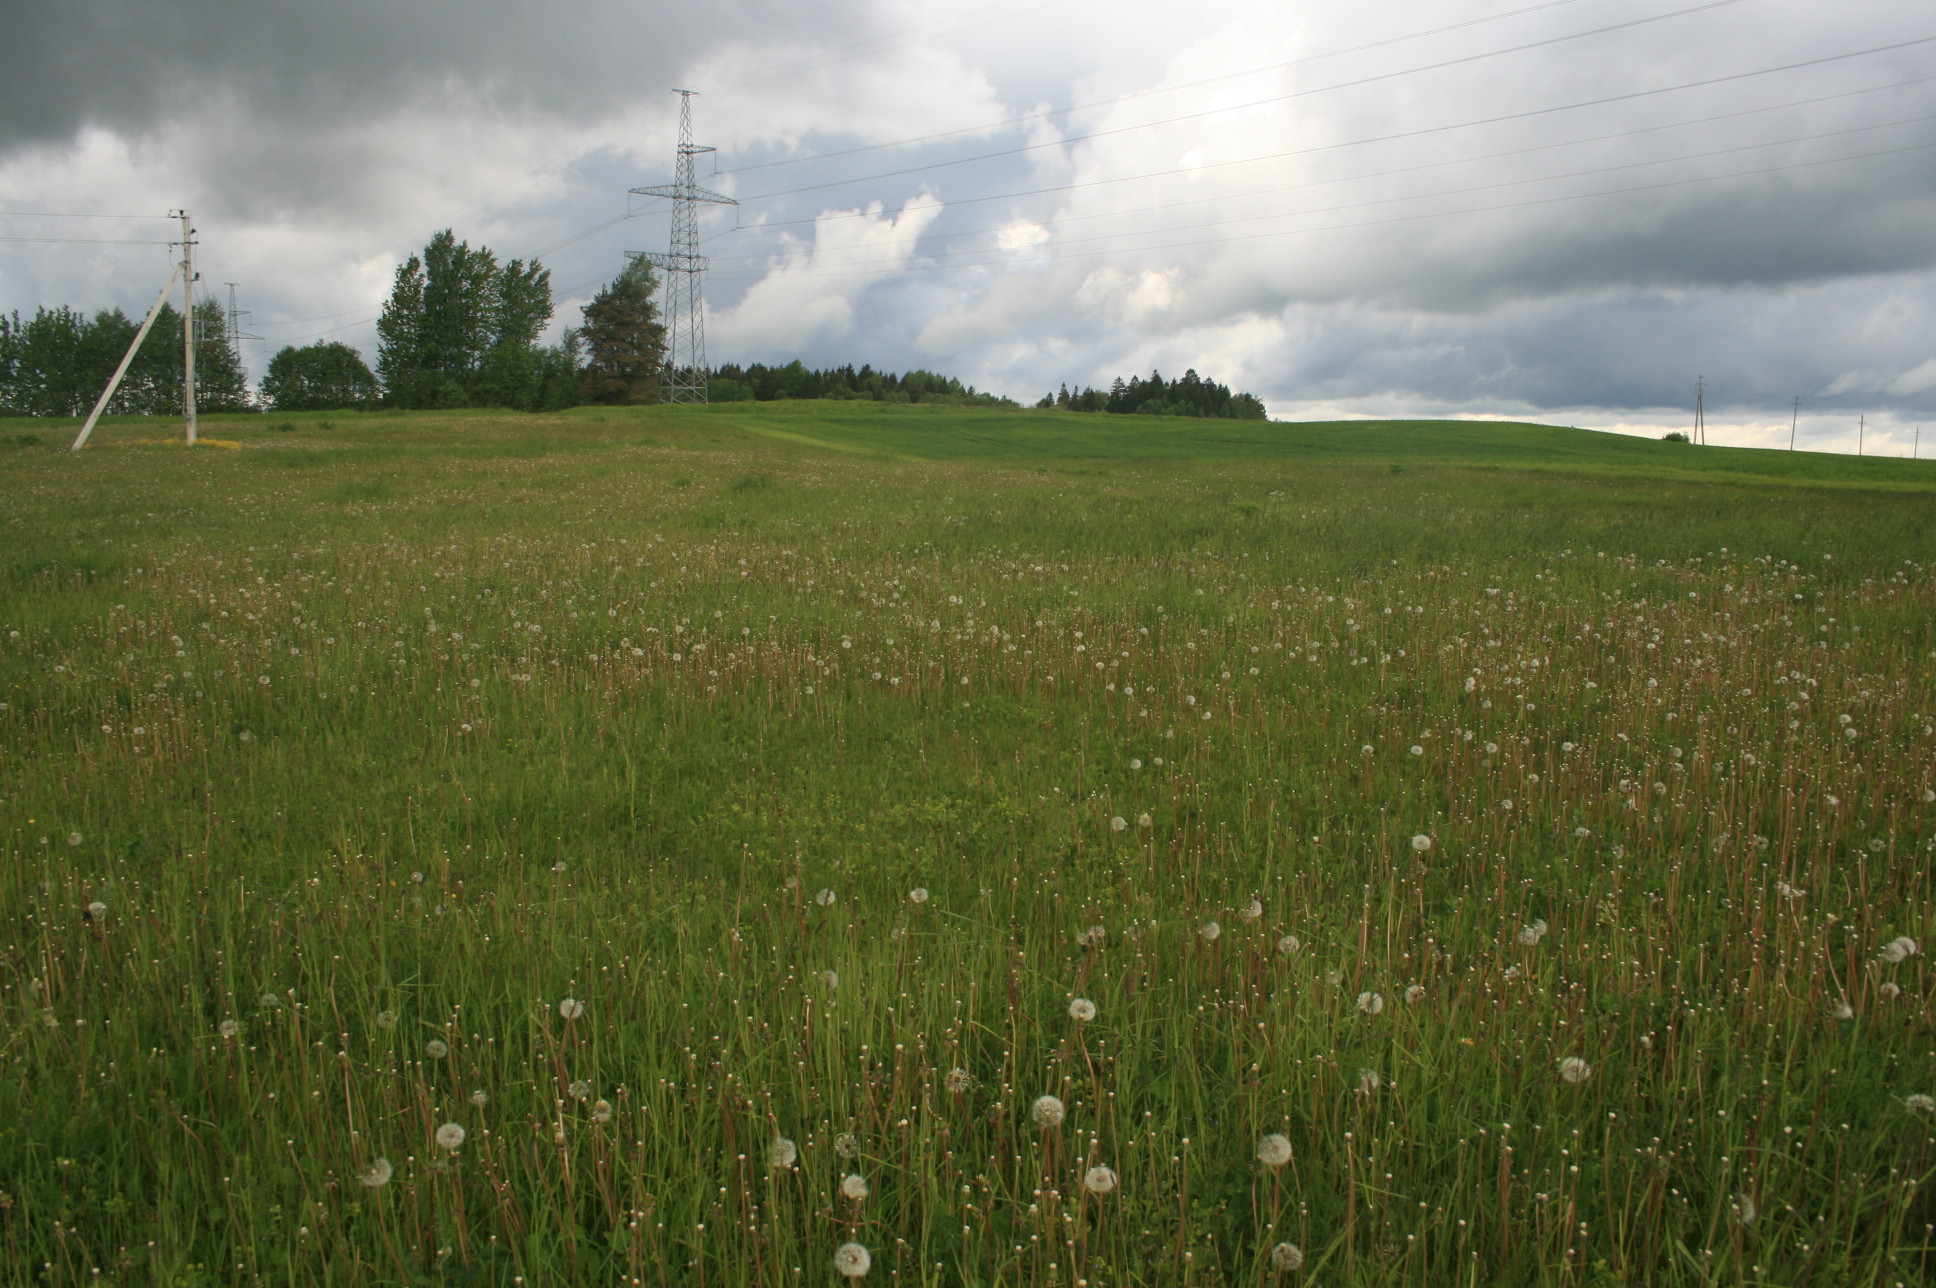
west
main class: Grassland
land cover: Grassland without tree/shrub cover
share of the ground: > 75 %
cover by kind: herbaceous plants 100 %
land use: Agriculture (excluding fallow land and kitchen gardens)
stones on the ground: < 10 %
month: May
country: LT
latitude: 55.9338
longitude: 21.9767
